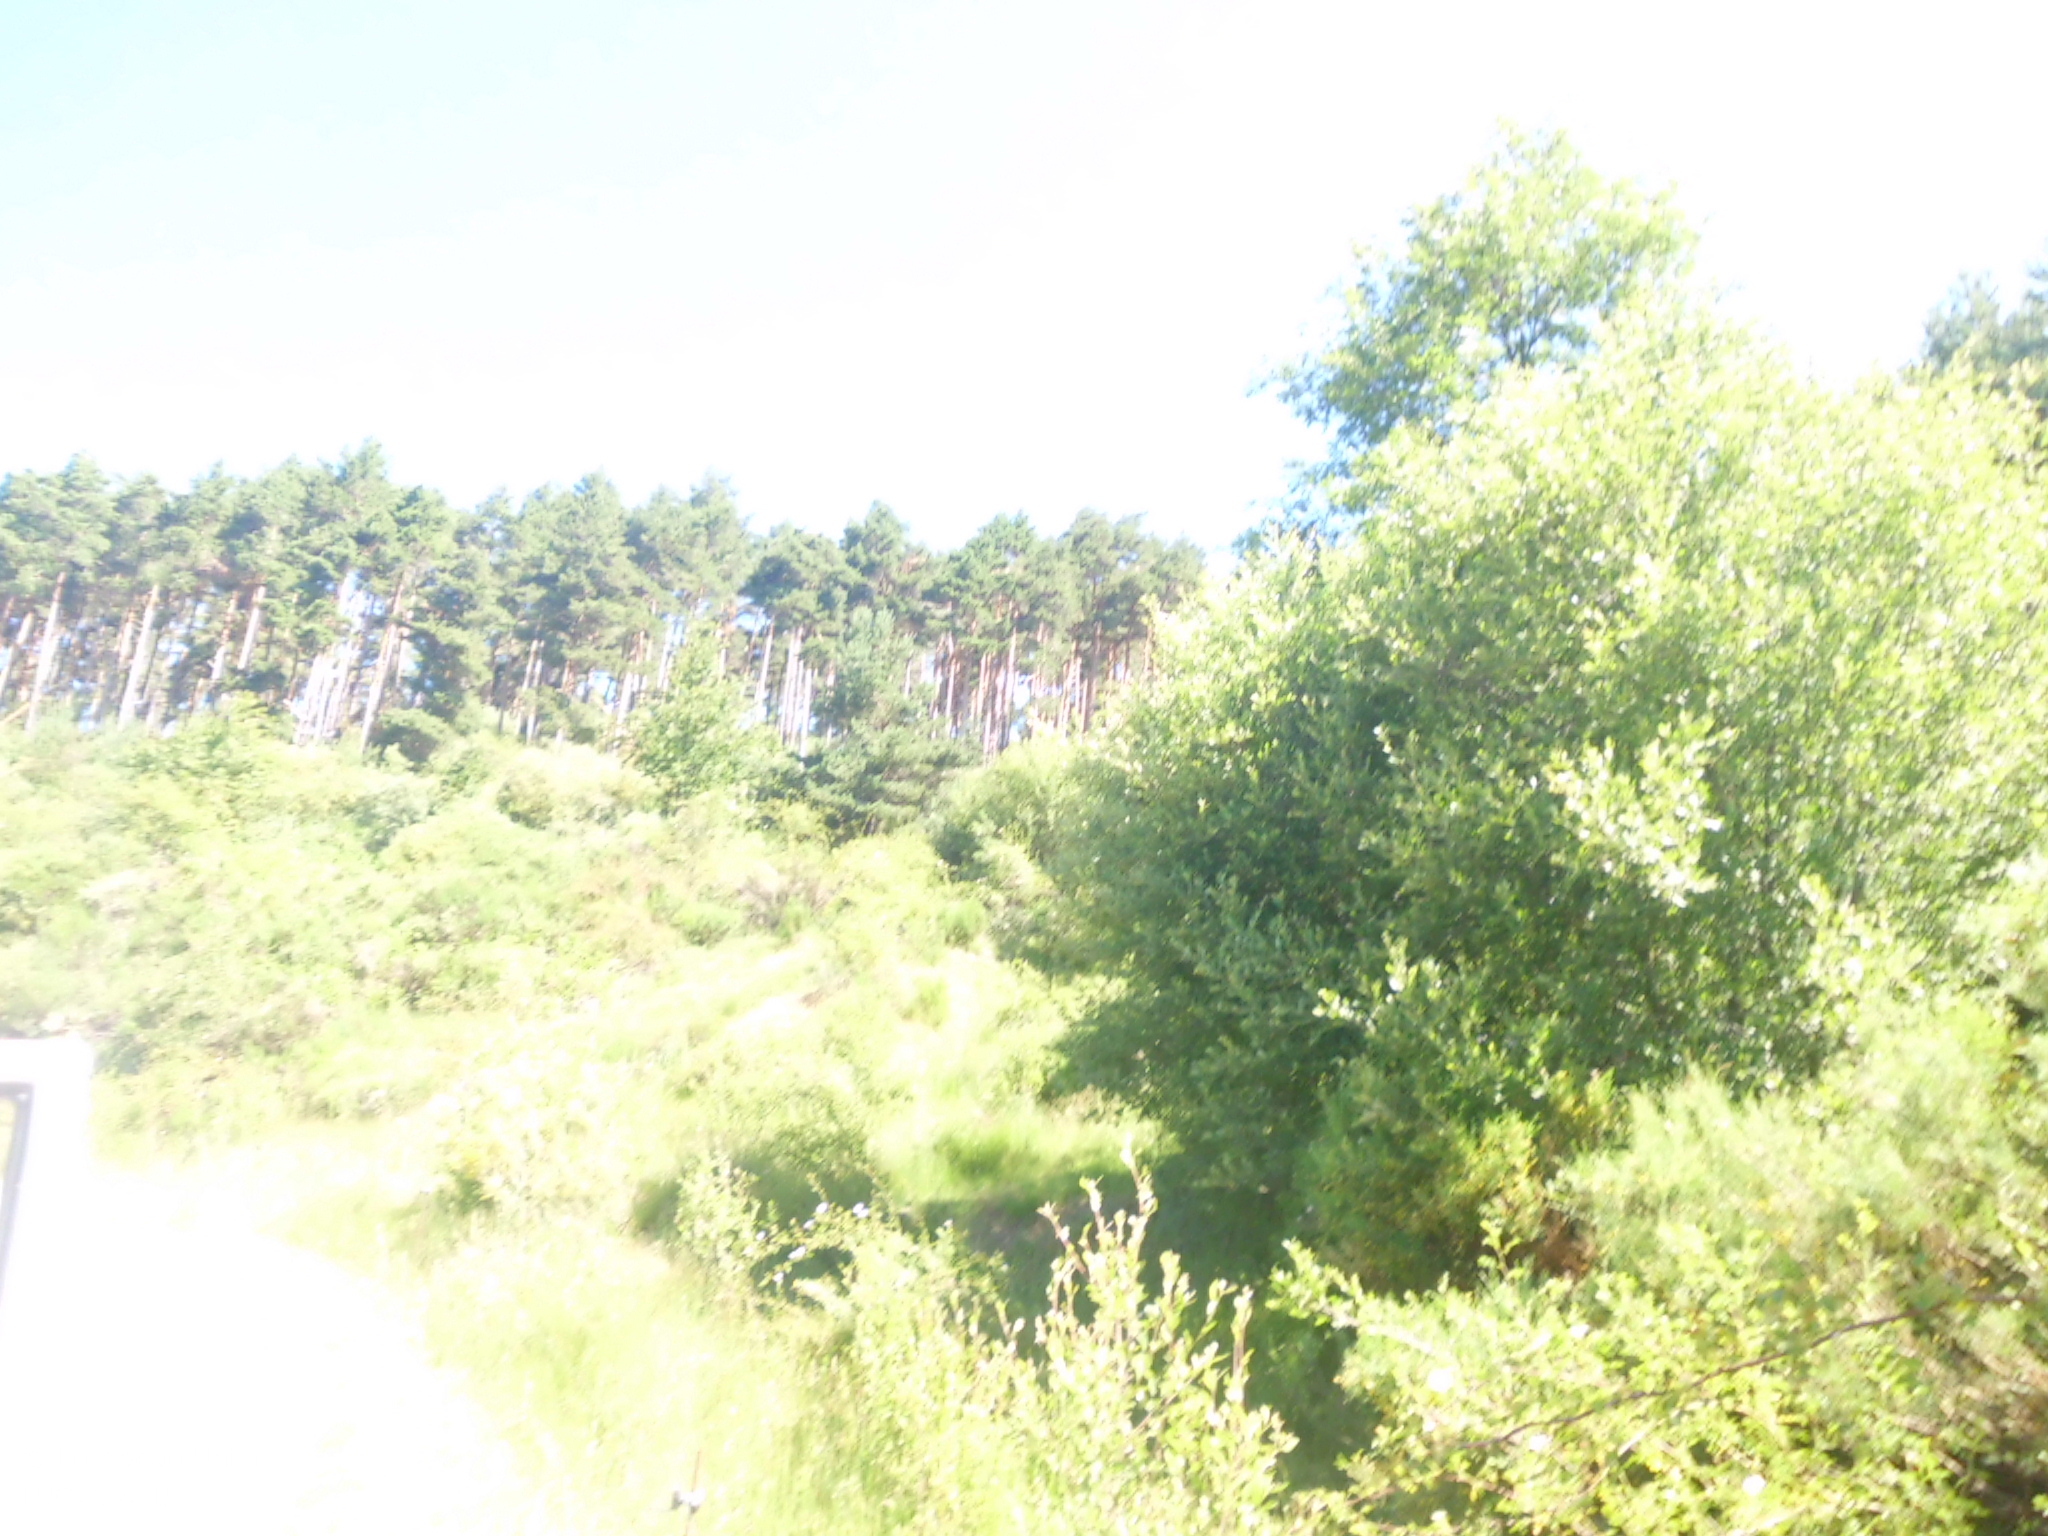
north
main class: Woodland
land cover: Pine dominated mixed woodland
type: coniferous forest of the mediterranean region
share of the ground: > 75 %
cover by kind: coniferous forest trees 60 %, broadleaved forest trees 40 %
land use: Forestry
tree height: > 5 m
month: June
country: ES
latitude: 42.8067
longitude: -4.9197
